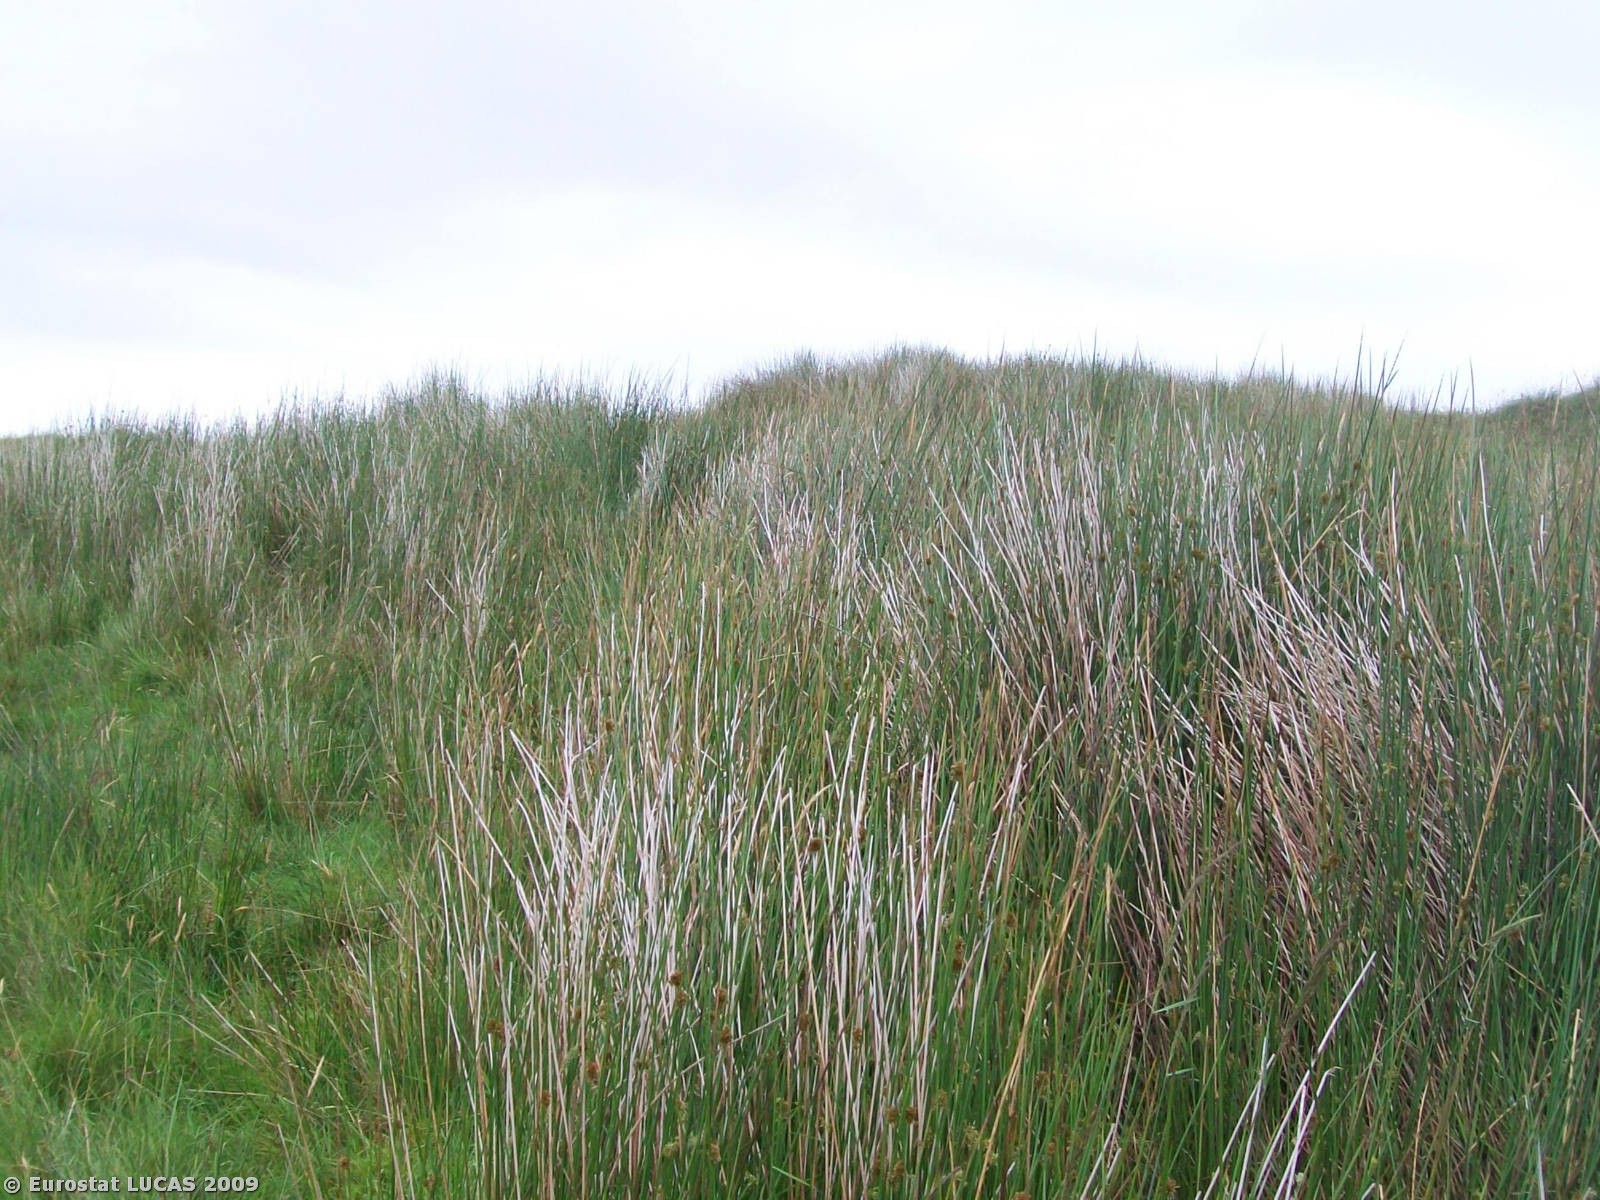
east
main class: Wetlands
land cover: Peatbogs
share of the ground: > 75 %
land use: Unused
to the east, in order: Peatbogs
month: July
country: GB
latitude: 54.7409
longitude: -6.7674
